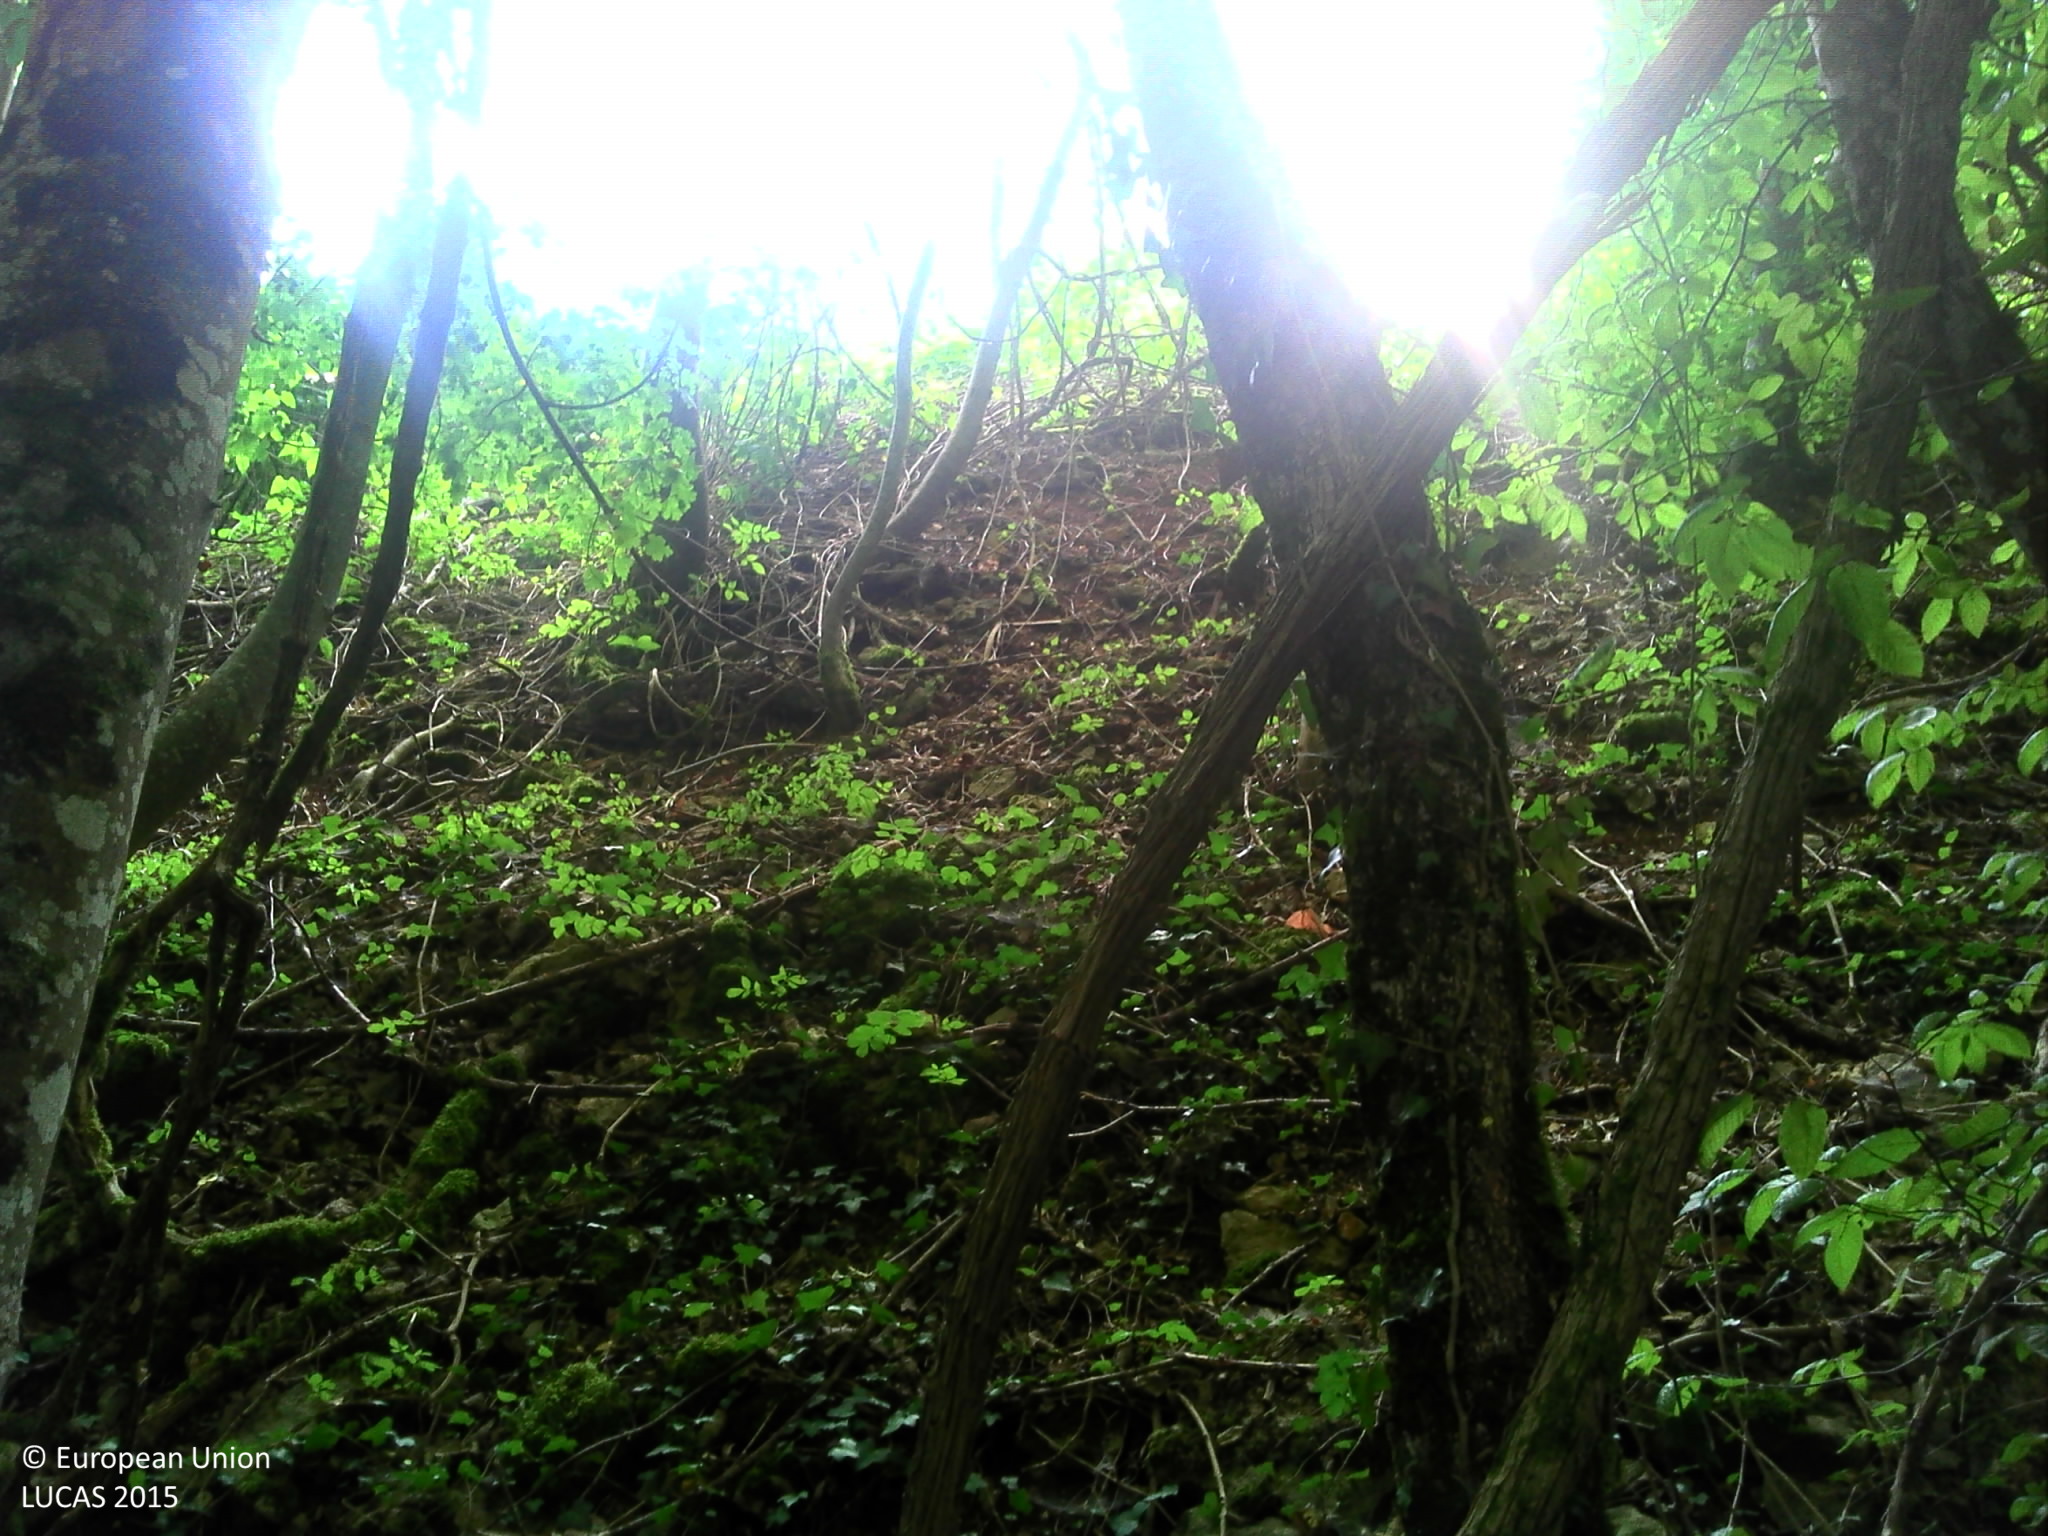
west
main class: Woodland
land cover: Broadleaved woodland
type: mesophytic deciduous forest
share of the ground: > 75 %
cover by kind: broadleaved forest trees 85 %, herbaceous plants 10 %, lichens and mosses 5 %
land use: Forestry
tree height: > 5 m
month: July
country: FR
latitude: 48.0810
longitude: 5.1534
